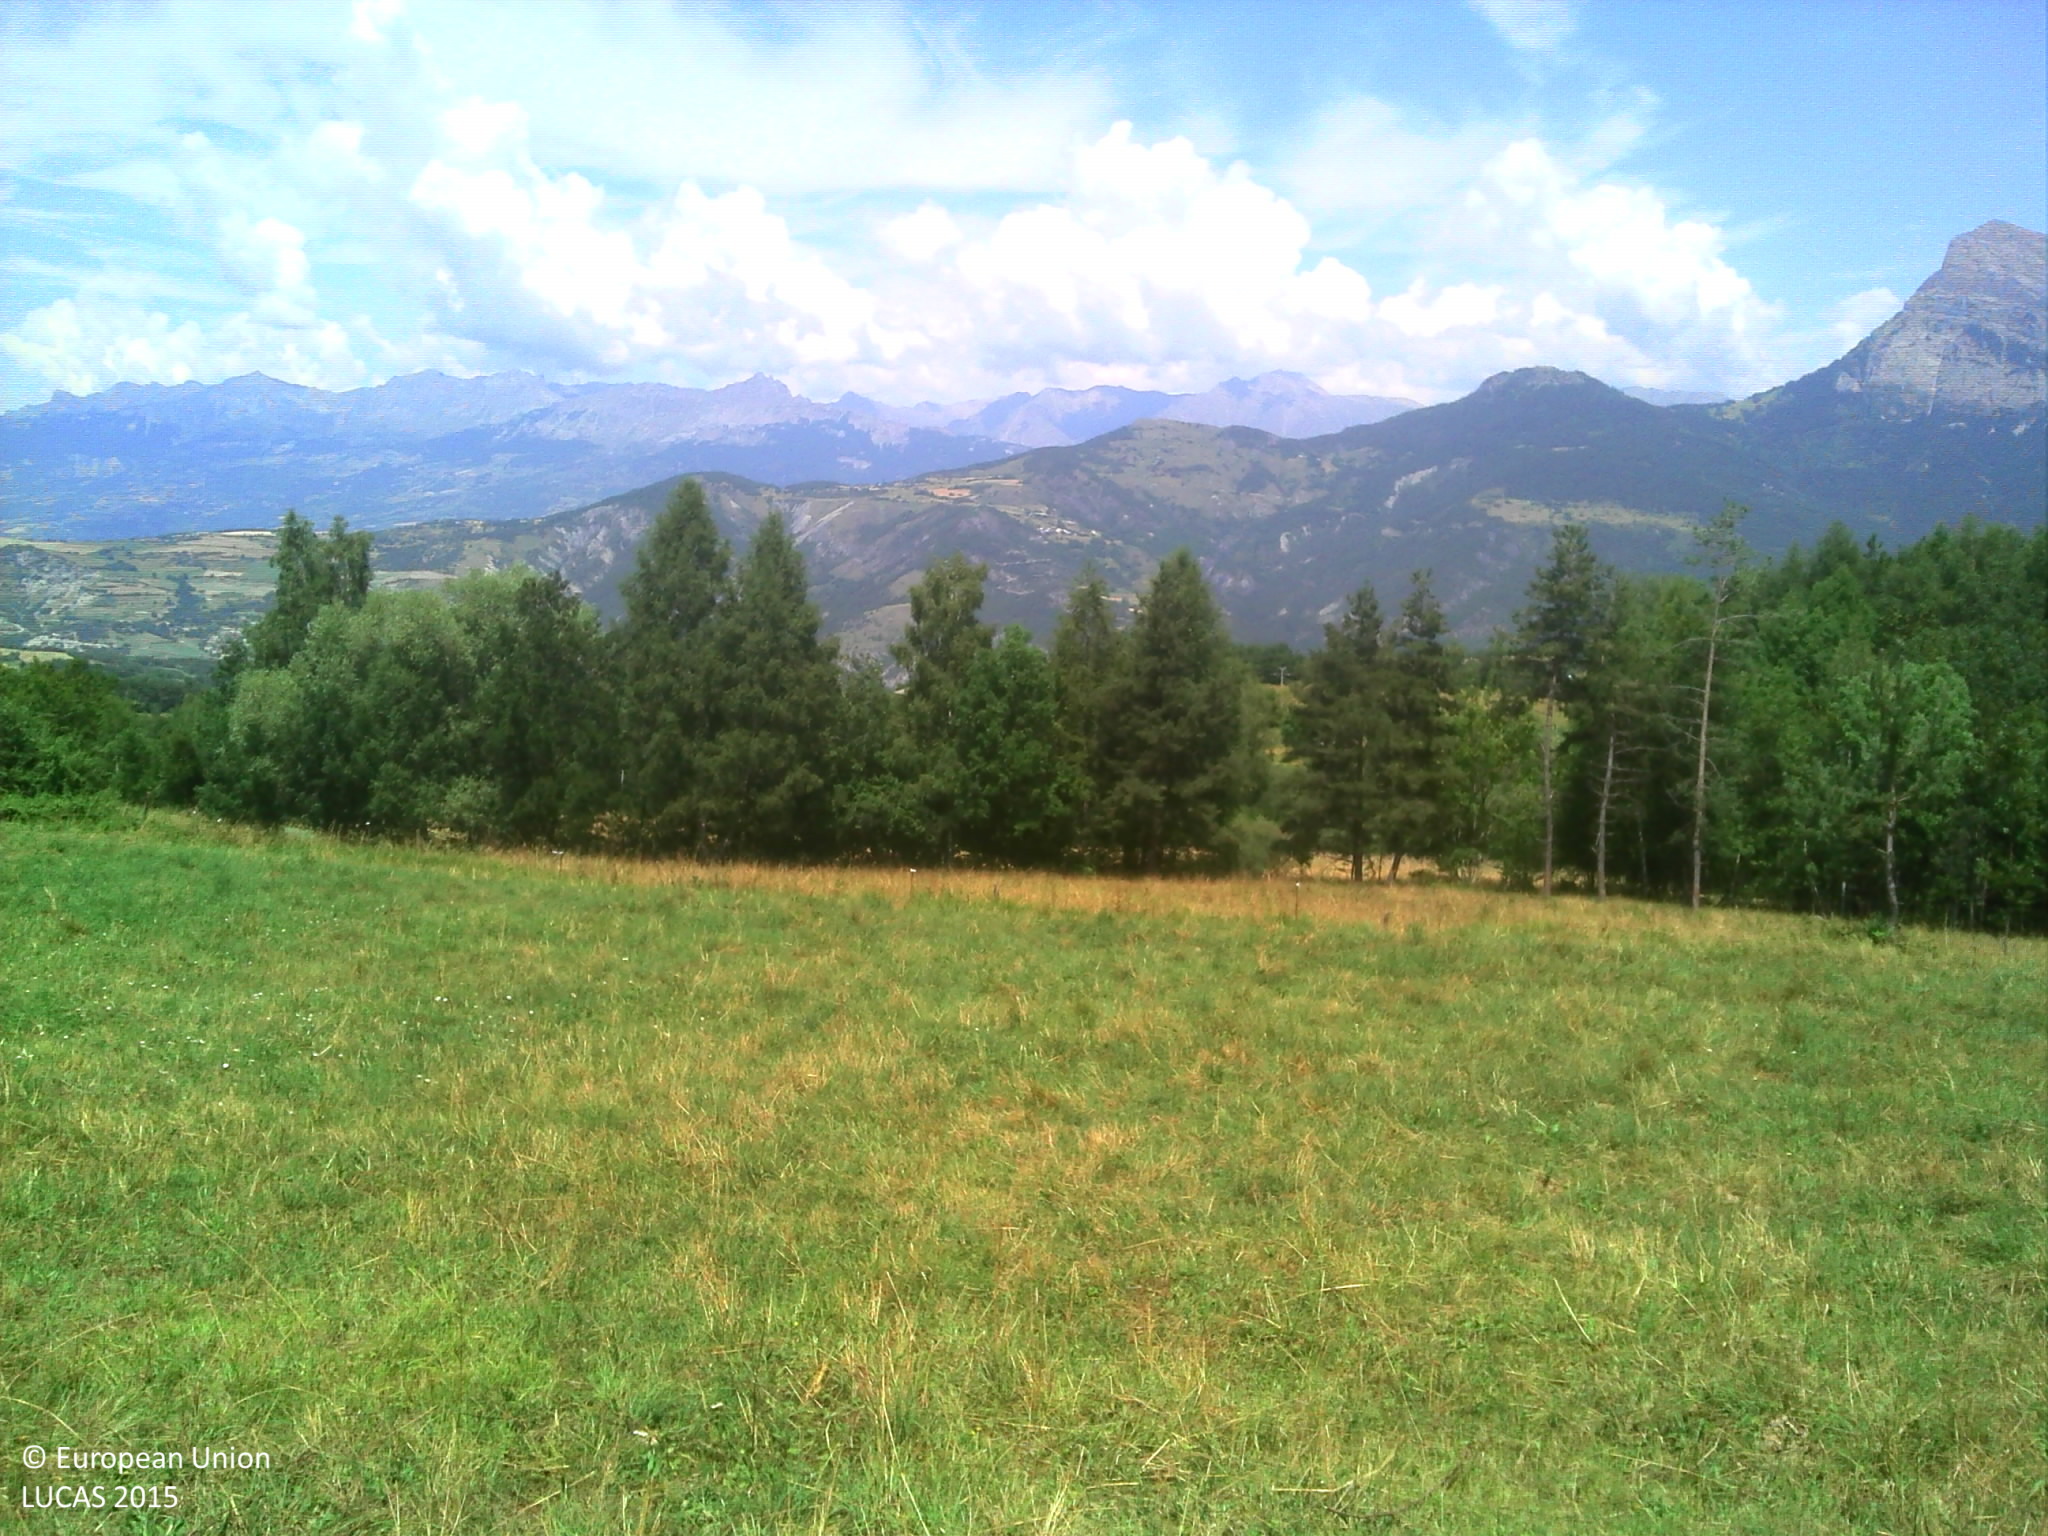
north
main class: Grassland
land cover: Grassland without tree/shrub cover
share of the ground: > 75 %
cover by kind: herbaceous plants 90 %, consolidated bare surface 10 %
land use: Agriculture (excluding fallow land and kitchen gardens)
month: July
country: FR
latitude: 44.4308
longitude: 6.3511
